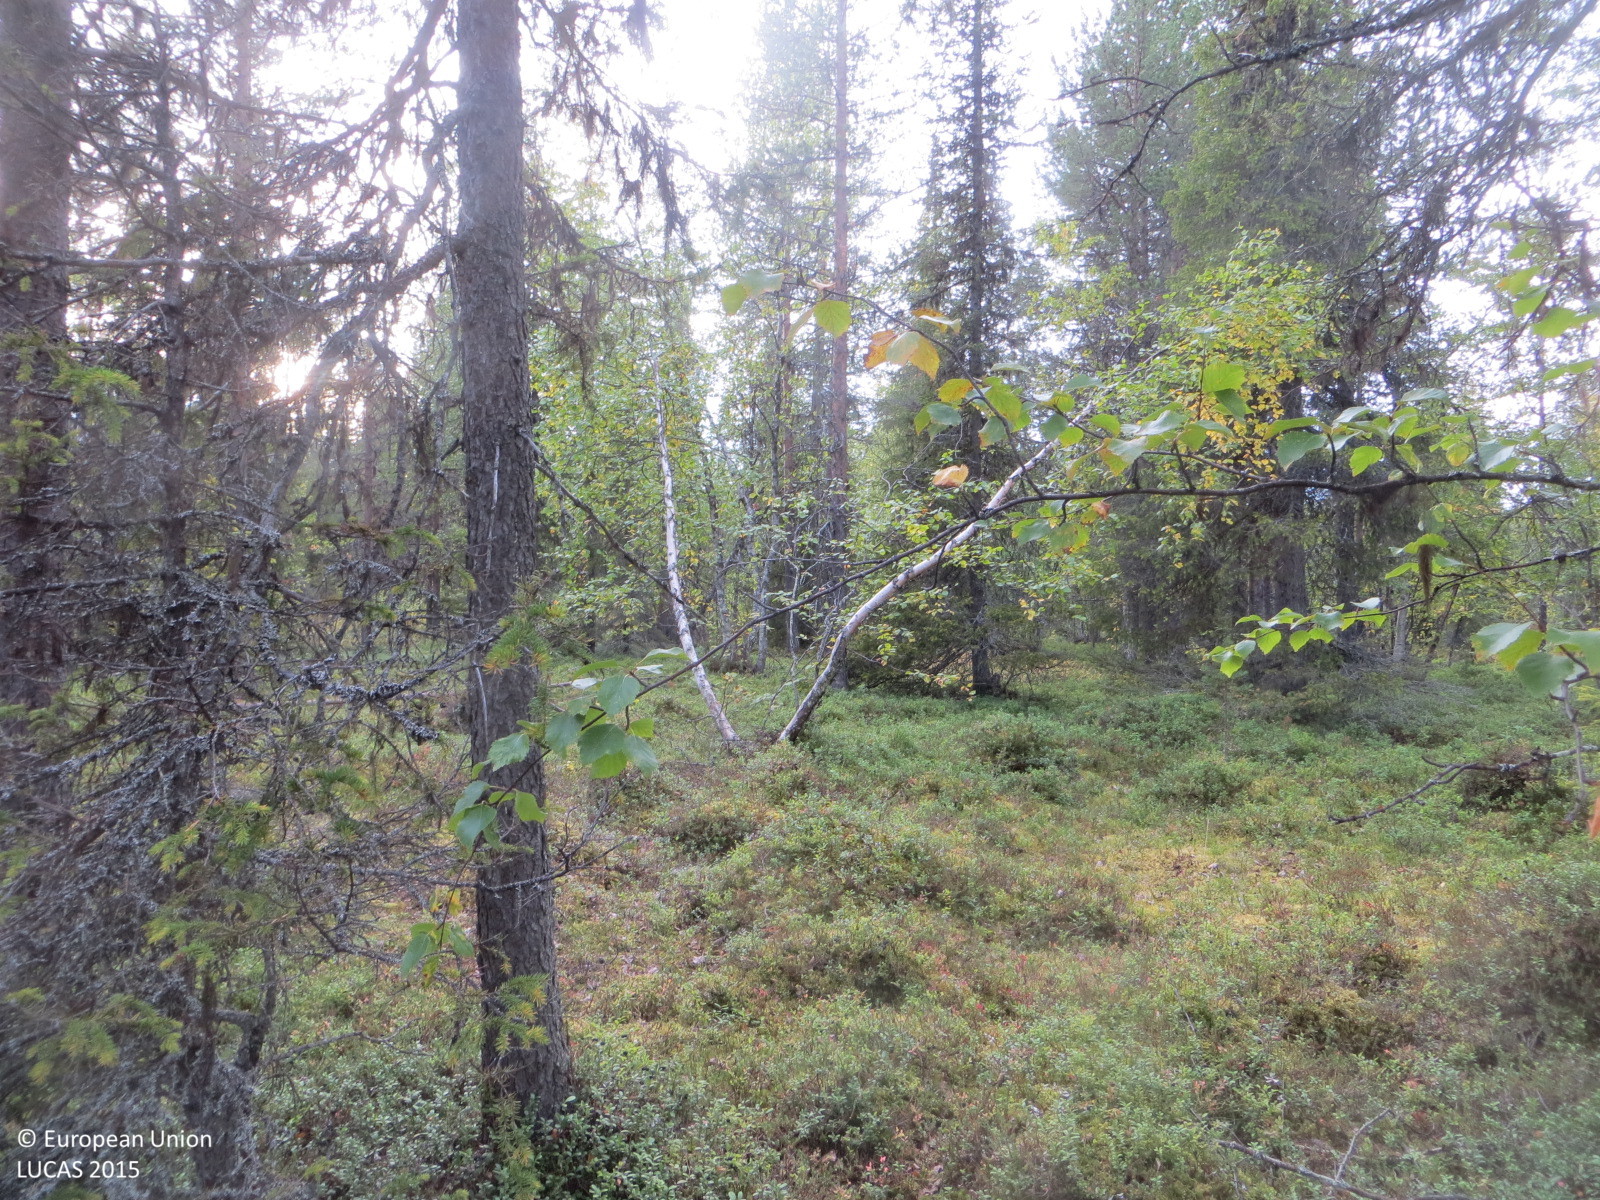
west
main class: Woodland
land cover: Other mixed woodland
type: boreal forest
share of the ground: 50 - 75 %
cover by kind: shrubs 50 %, coniferous forest trees 30 %, broadleaved forest trees 20 %
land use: Forestry
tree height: > 5 m
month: September
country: FI
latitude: 67.9046
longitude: 24.2430
